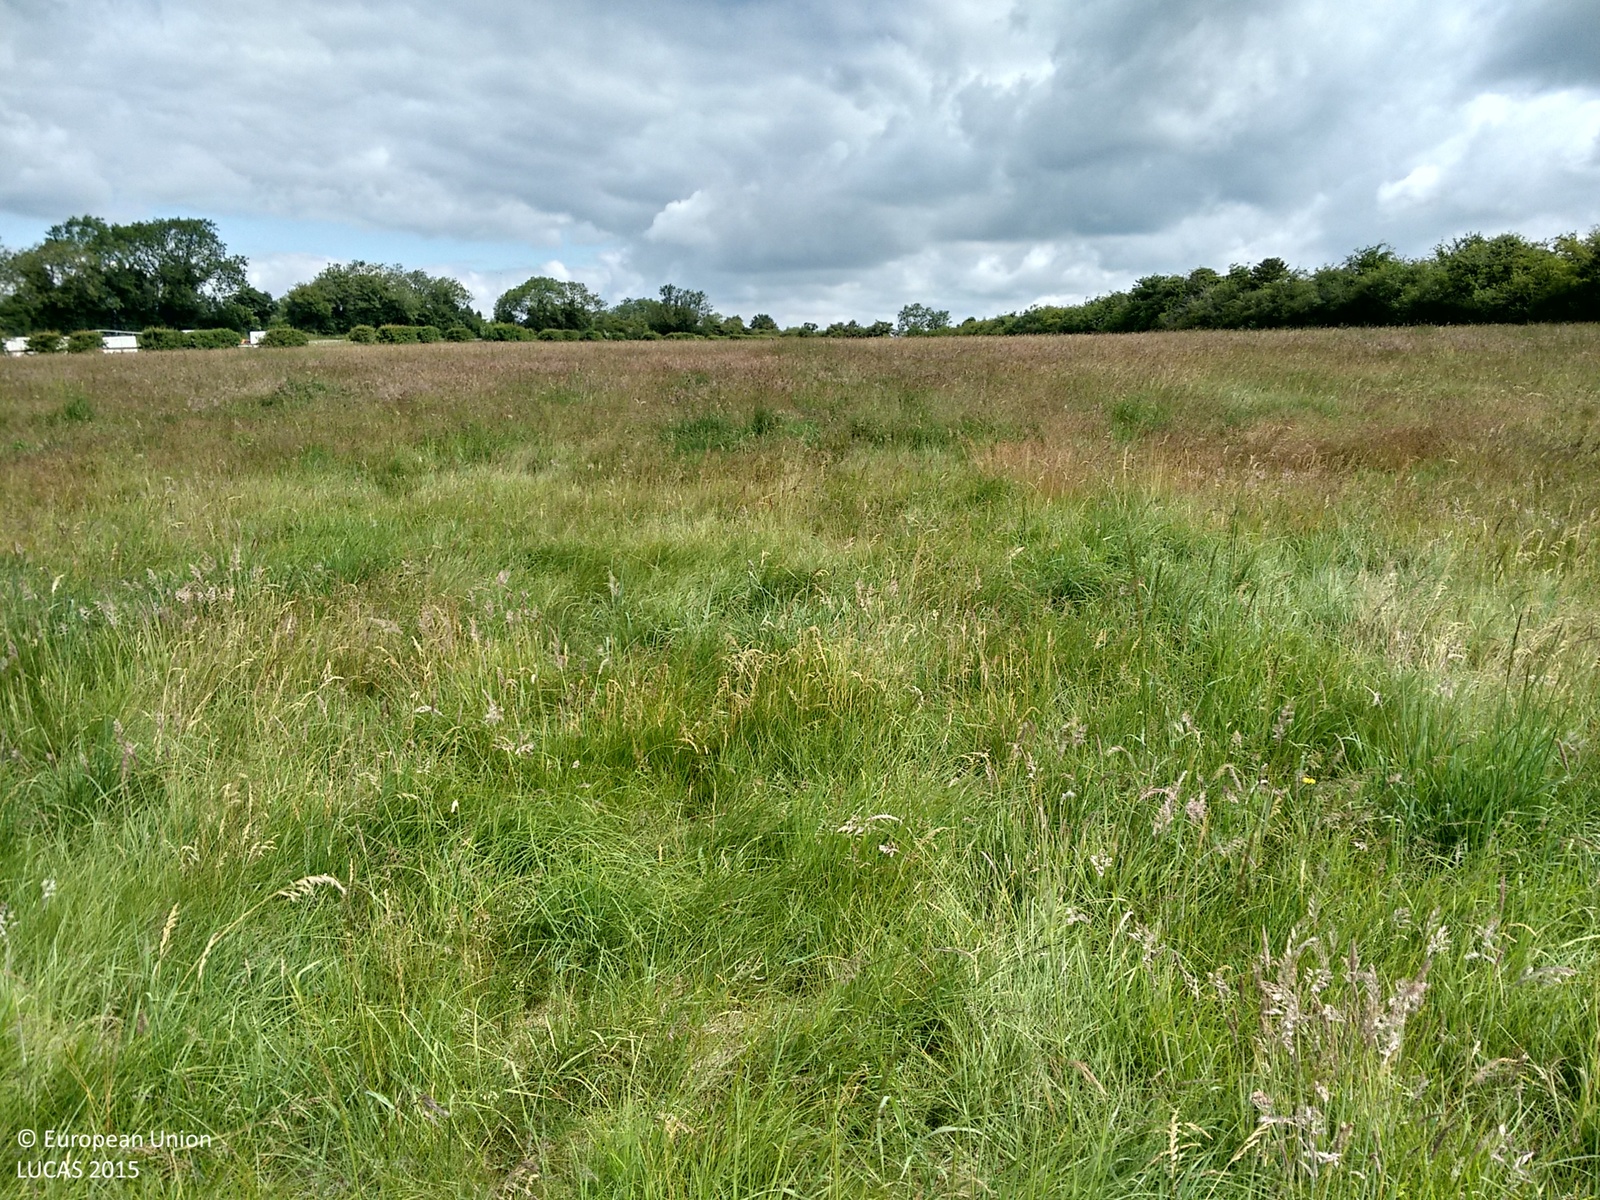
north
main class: Grassland
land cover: Grassland without tree/shrub cover
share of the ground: > 75 %
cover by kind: herbaceous plants 100 %
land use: Agriculture (excluding fallow land and kitchen gardens)
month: June
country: GB
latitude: 51.5220
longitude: -1.5384
